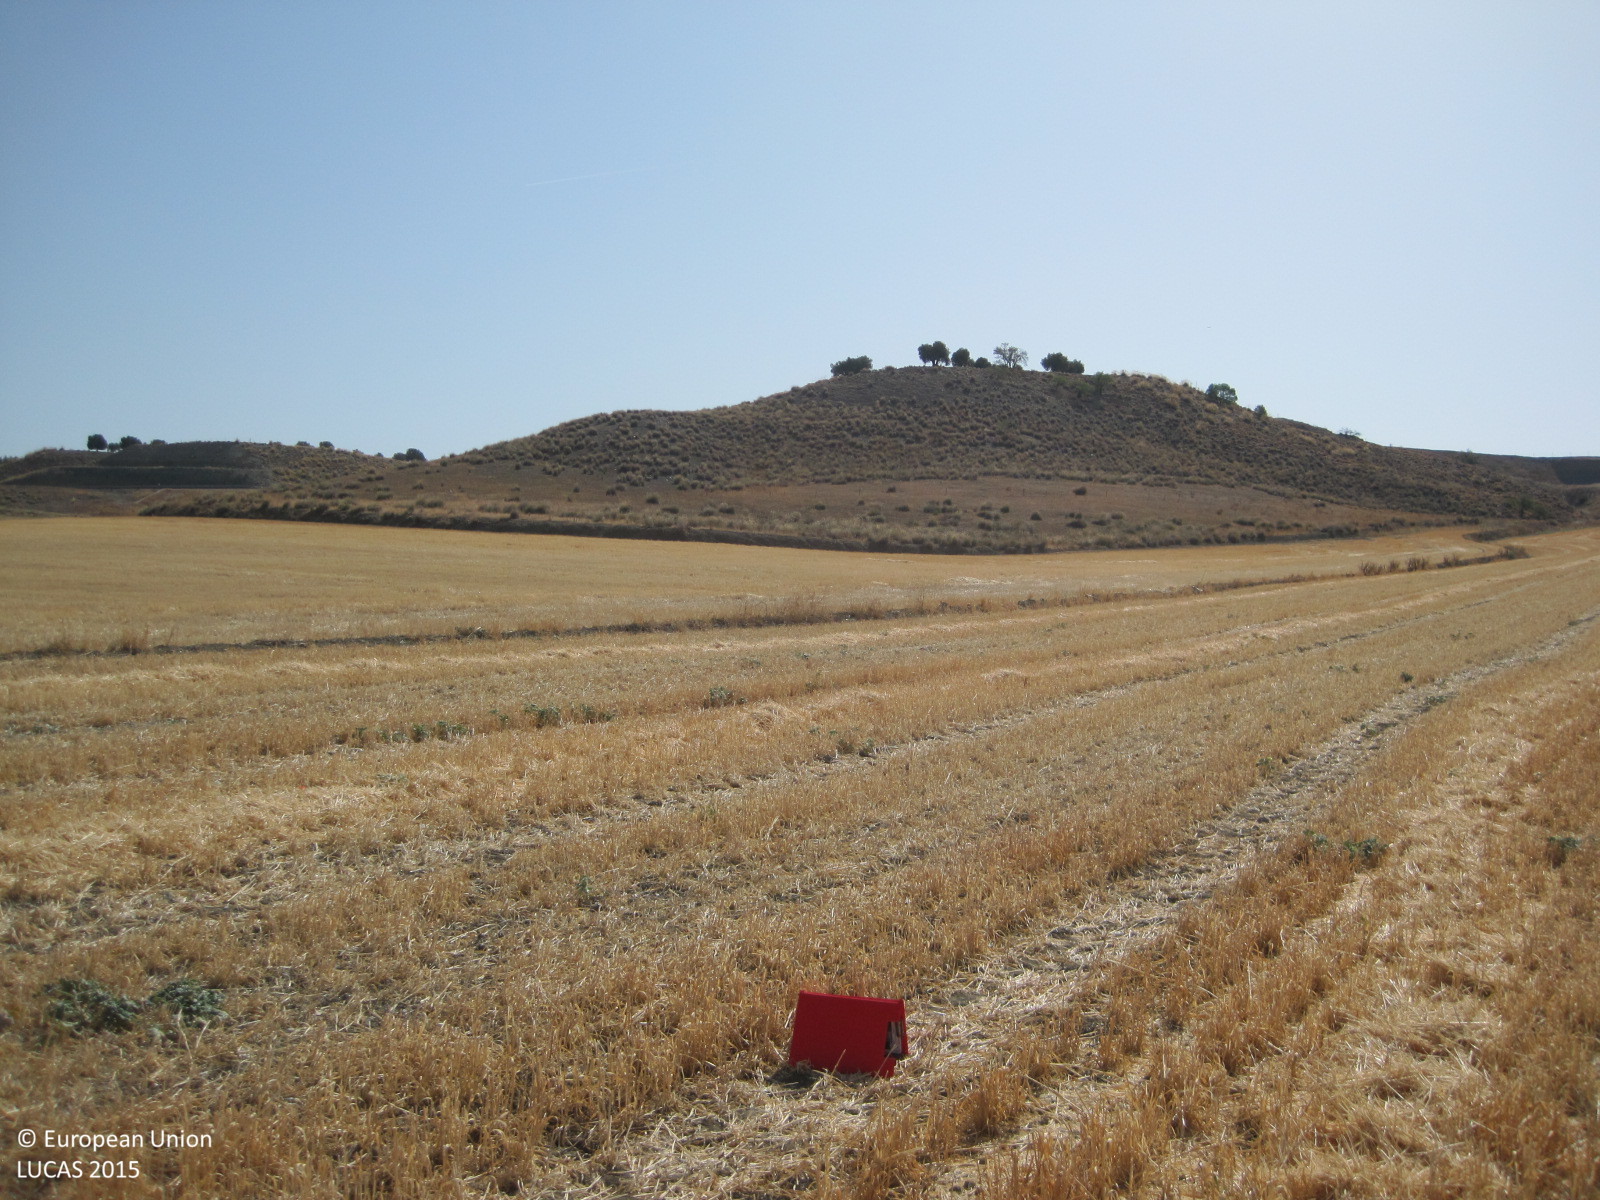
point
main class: Cropland
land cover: Barley
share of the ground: < 10 %
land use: Agriculture (excluding fallow land and kitchen gardens)
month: July
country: ES
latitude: 40.0376
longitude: -3.8045
